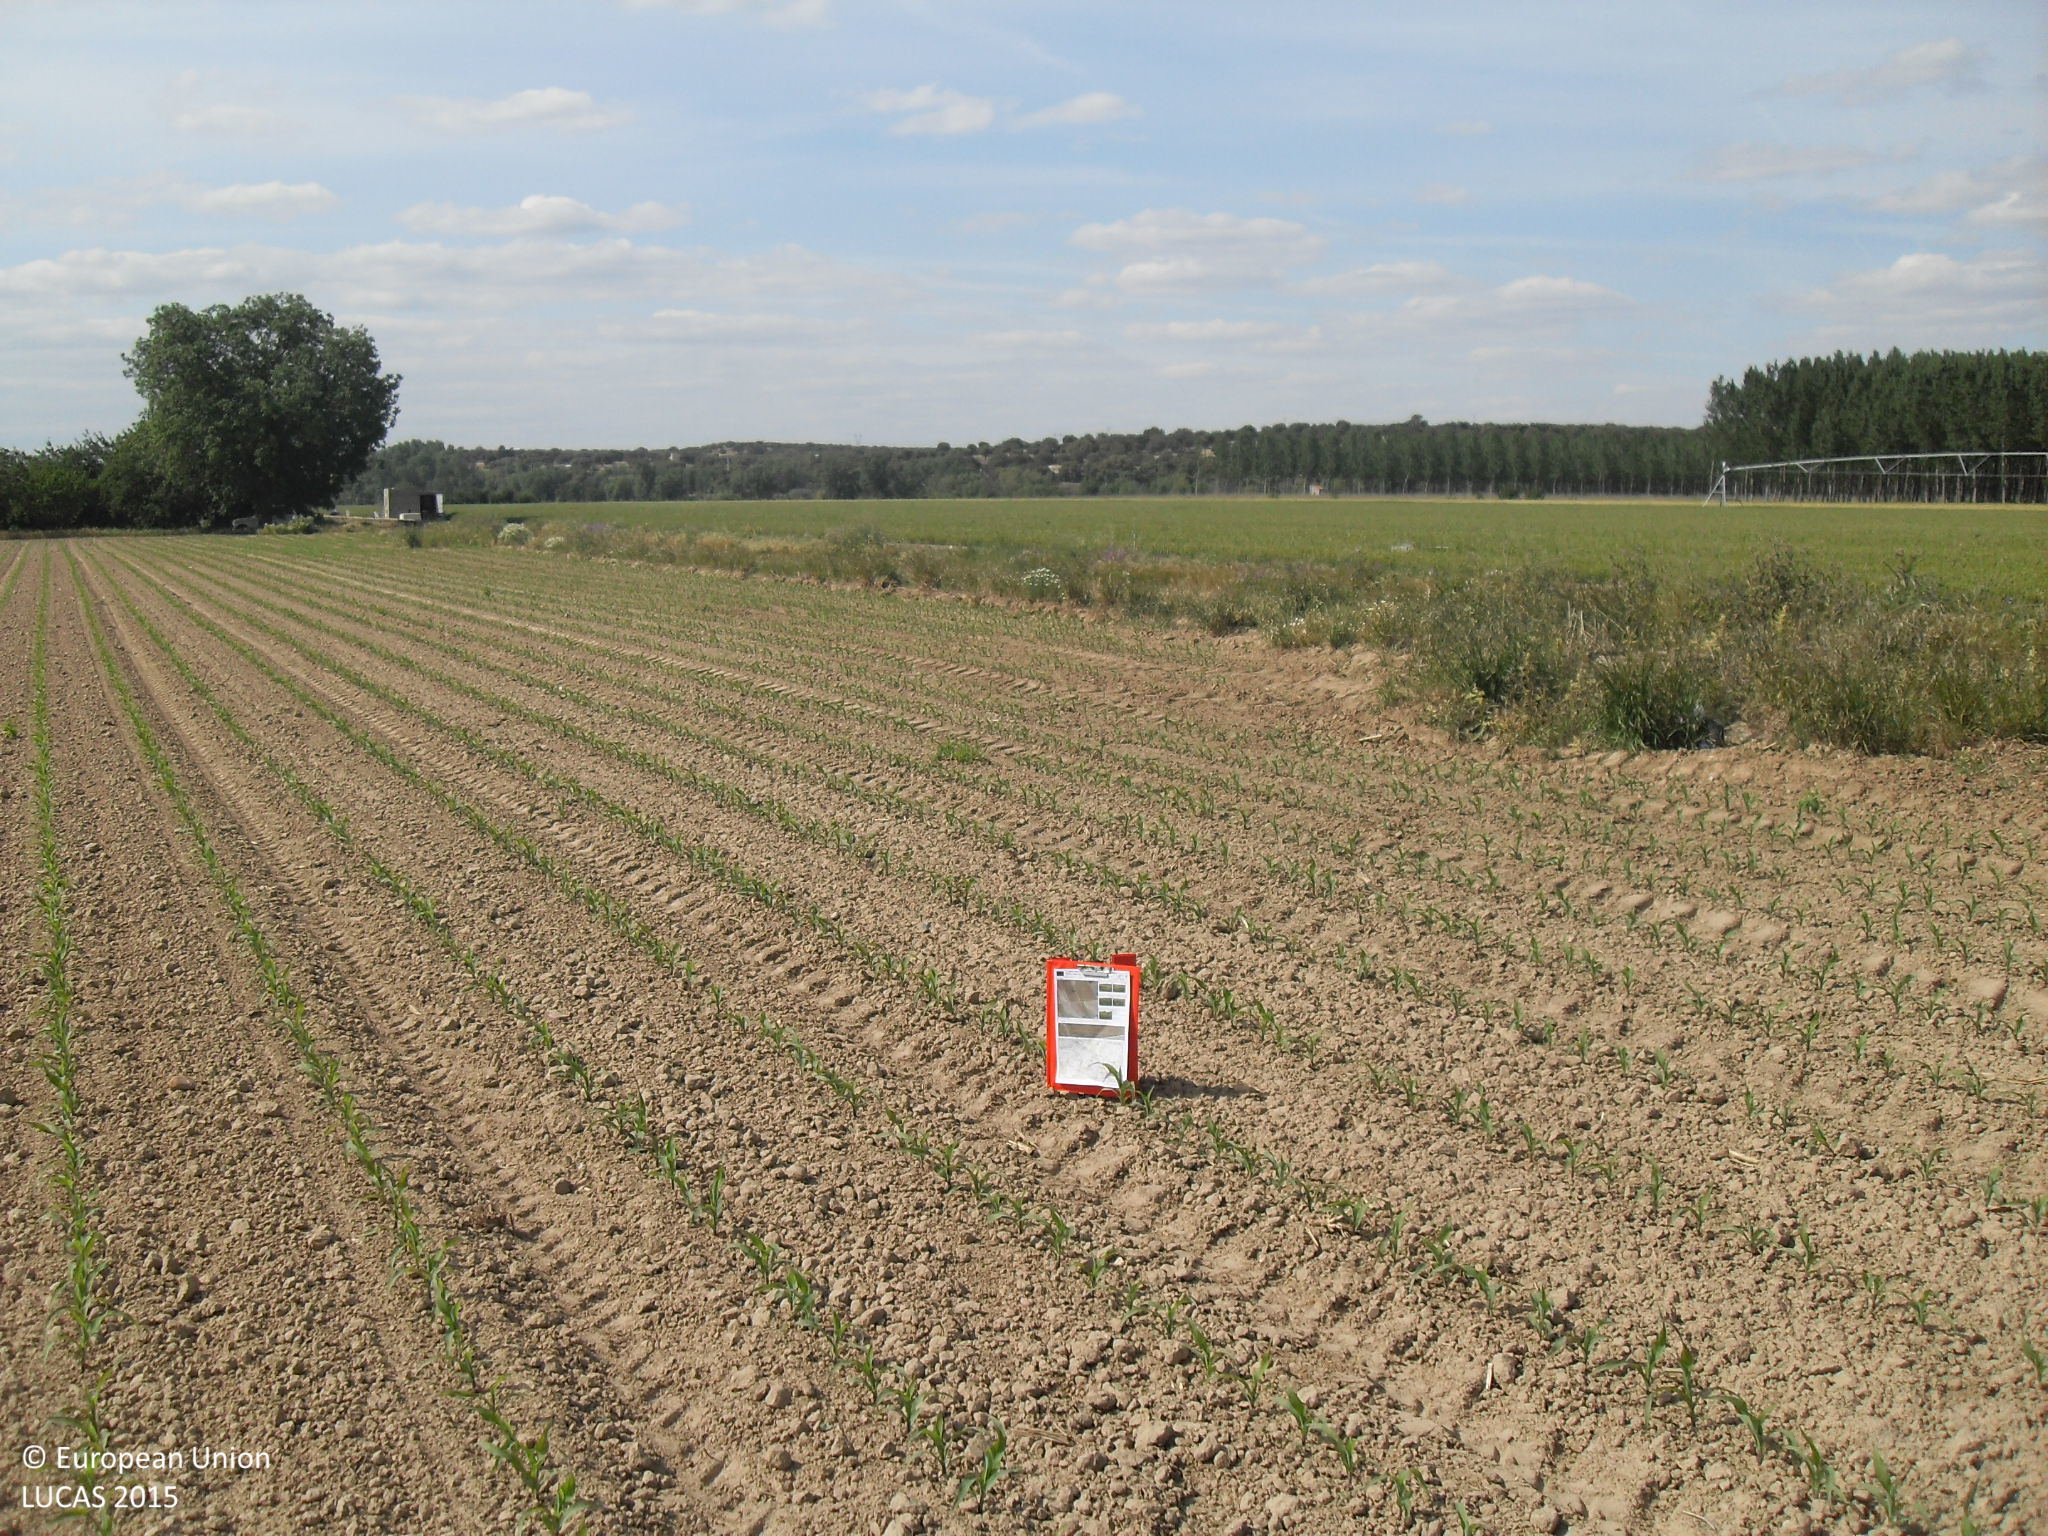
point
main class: Cropland
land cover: Maize
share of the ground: < 10 %
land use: Agriculture (excluding fallow land and kitchen gardens)
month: May
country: ES
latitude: 41.0280
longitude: -5.7435
